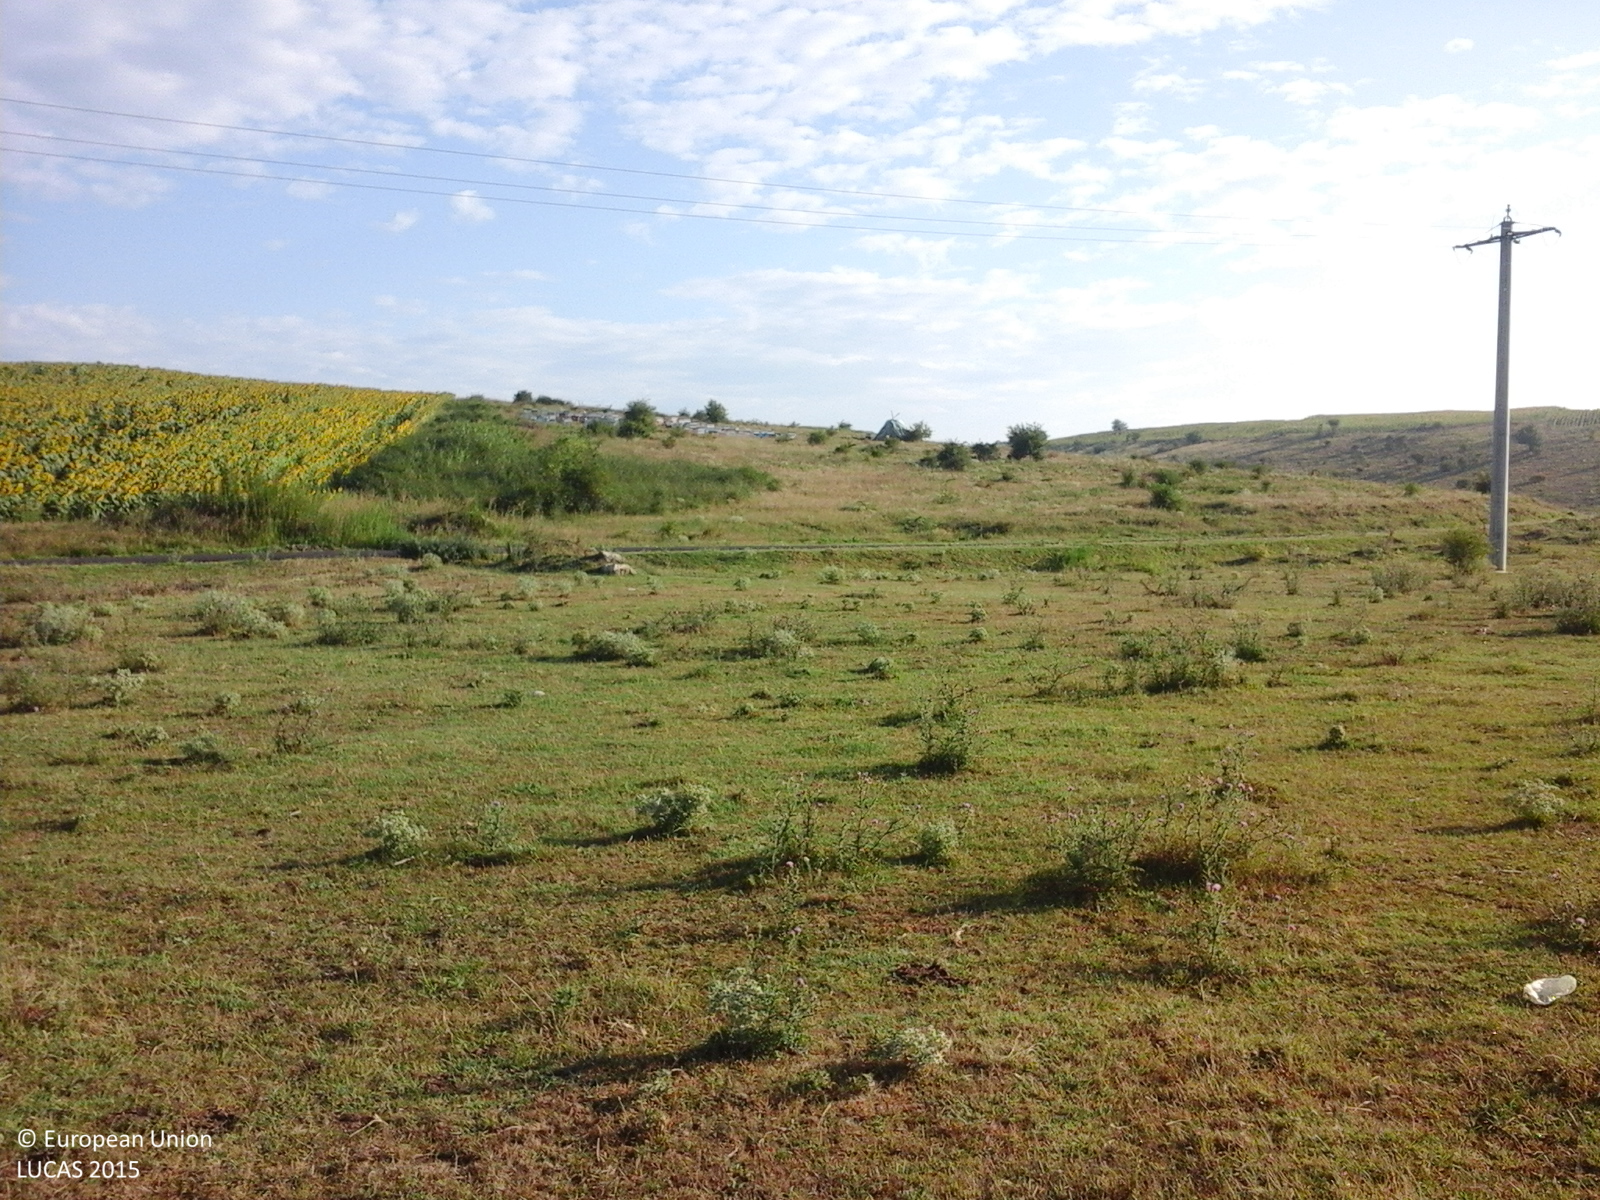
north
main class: Grassland
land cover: Grassland without tree/shrub cover
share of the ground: > 75 %
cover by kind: herbaceous plants 100 %
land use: Agriculture (excluding fallow land and kitchen gardens)
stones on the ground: < 10 %
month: July
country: RO
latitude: 46.1827
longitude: 27.7210
